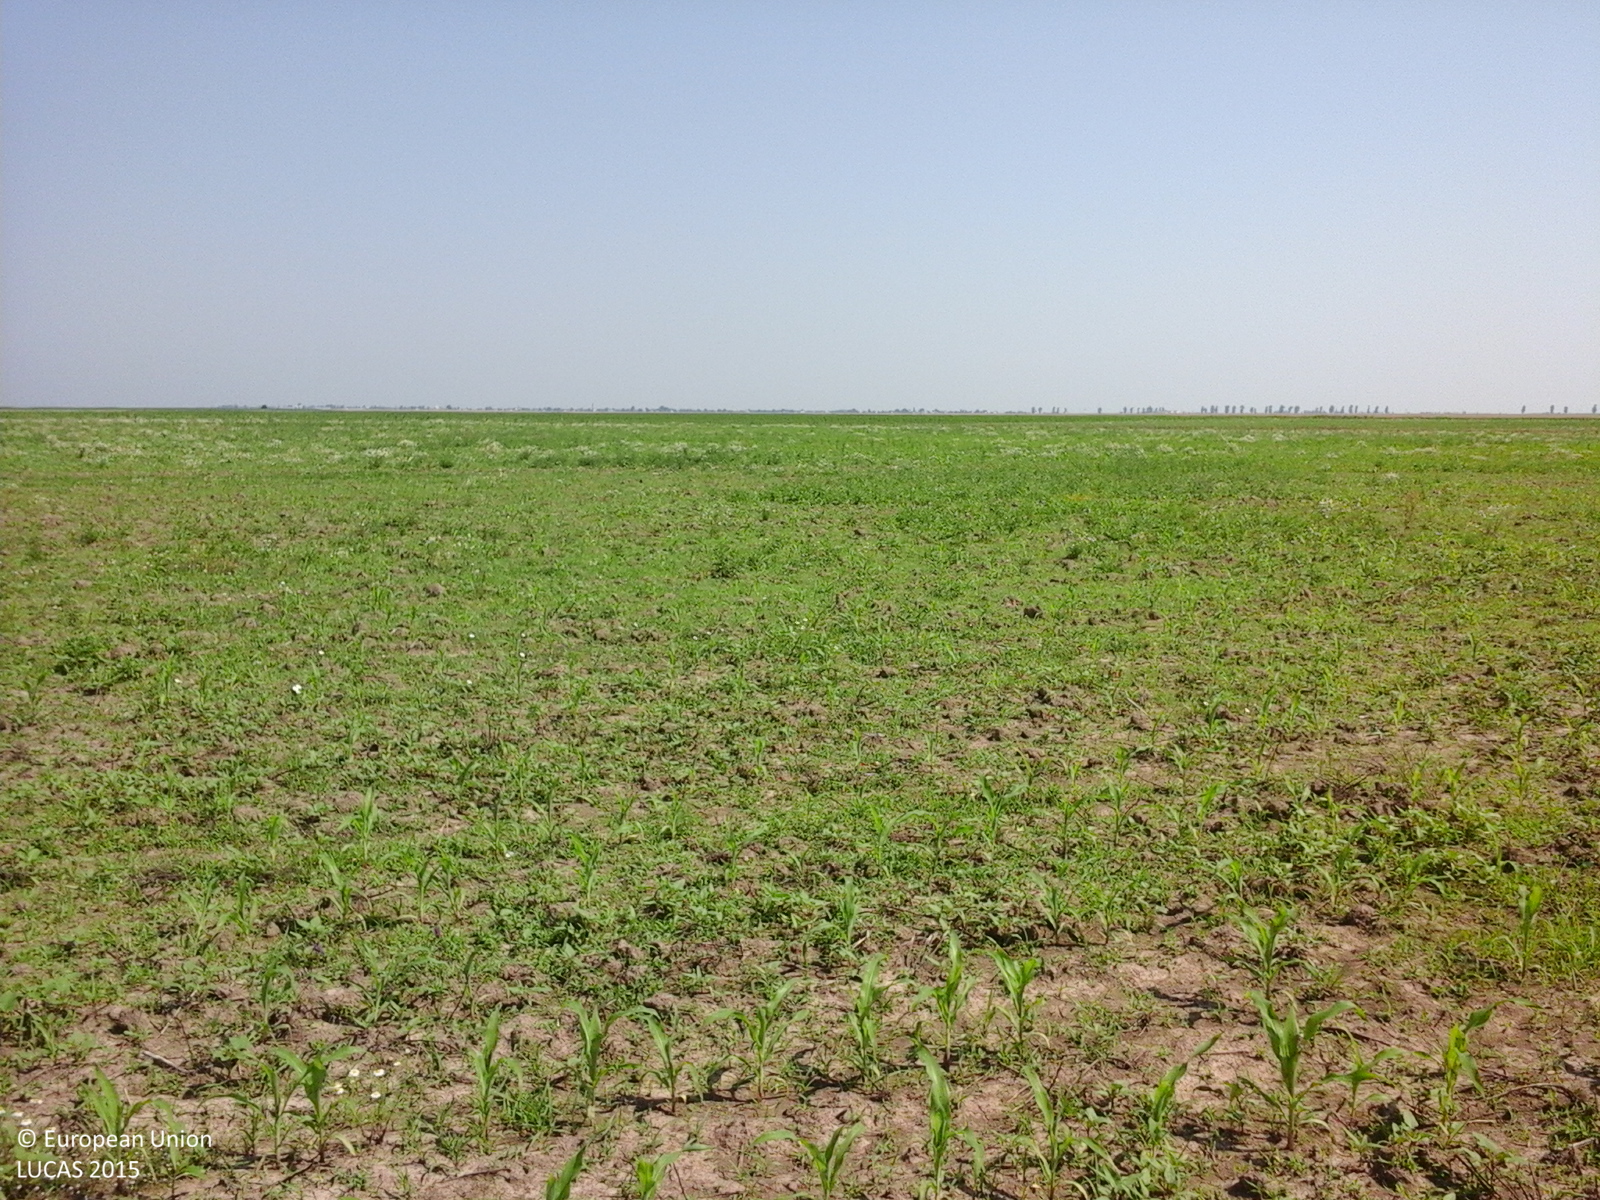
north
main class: Cropland
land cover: Maize
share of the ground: < 10 %
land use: Agriculture (excluding fallow land and kitchen gardens)
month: July
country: RO
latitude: 44.5292
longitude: 24.9152
